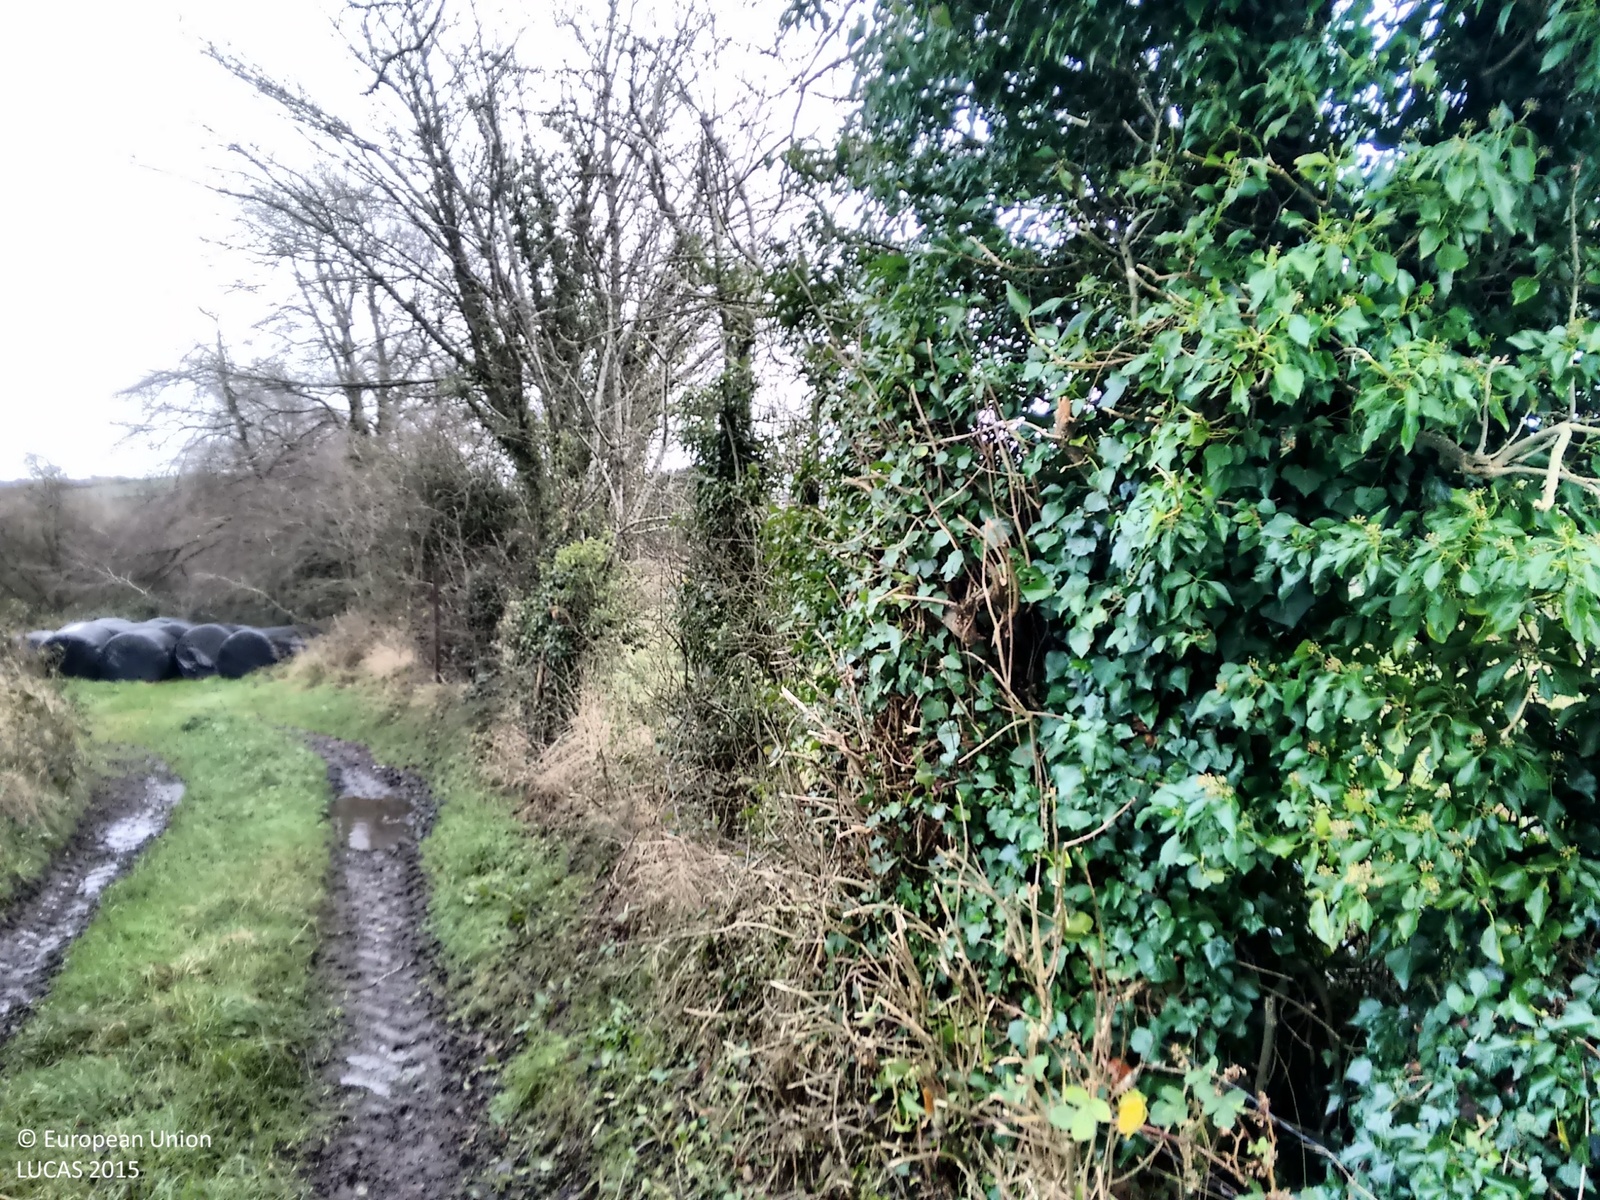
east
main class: Grassland
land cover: Grassland without tree/shrub cover
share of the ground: > 75 %
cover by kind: herbaceous plants 100 %
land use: Agriculture (excluding fallow land and kitchen gardens)
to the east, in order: Grassland without tree/shrub cover; Broadleaved woodland; Grassland without tree/shrub cover; Abandoned hedges; Grassland without tree/shrub cover; Abandoned hedges; Grassland without tree/shrub cover
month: December
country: IE
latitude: 54.0825
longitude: -7.0010
